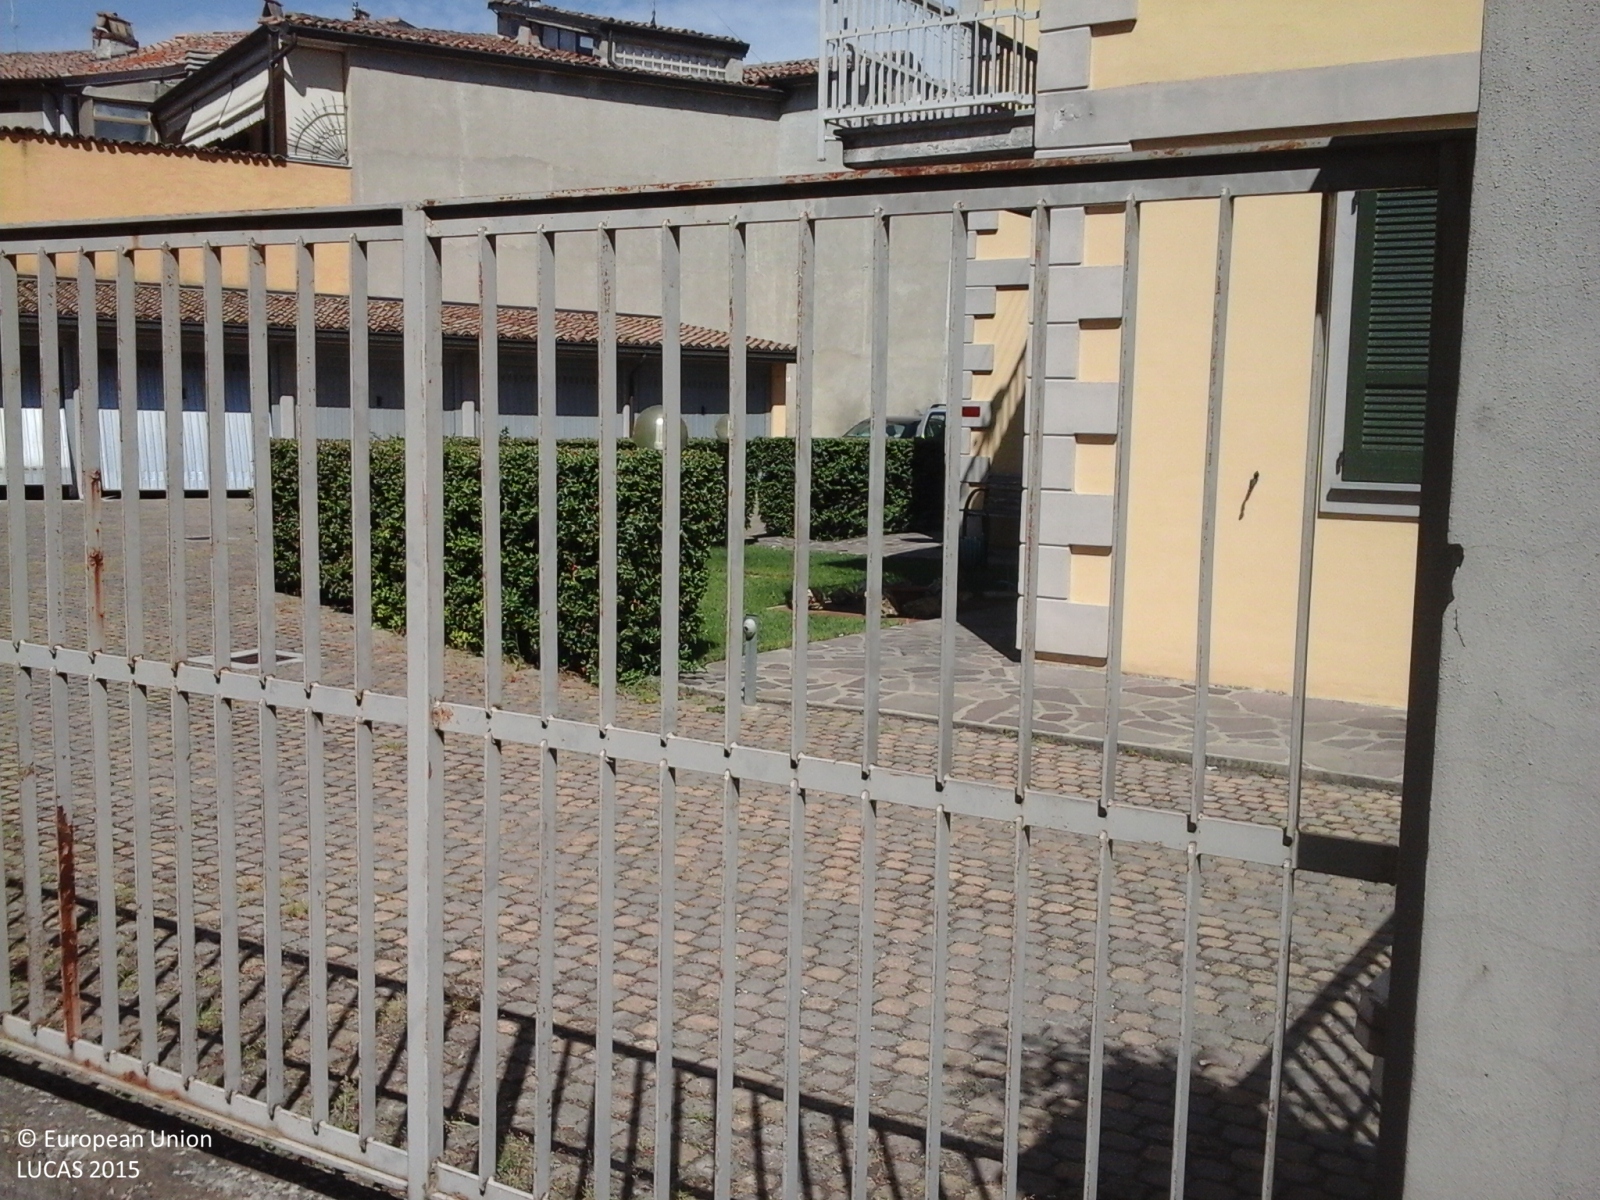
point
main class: Grassland
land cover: Grassland without tree/shrub cover
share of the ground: > 75 %
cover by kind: herbaceous plants 100 %
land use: Residential
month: July
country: IT
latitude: 45.0141
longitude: 9.1262
